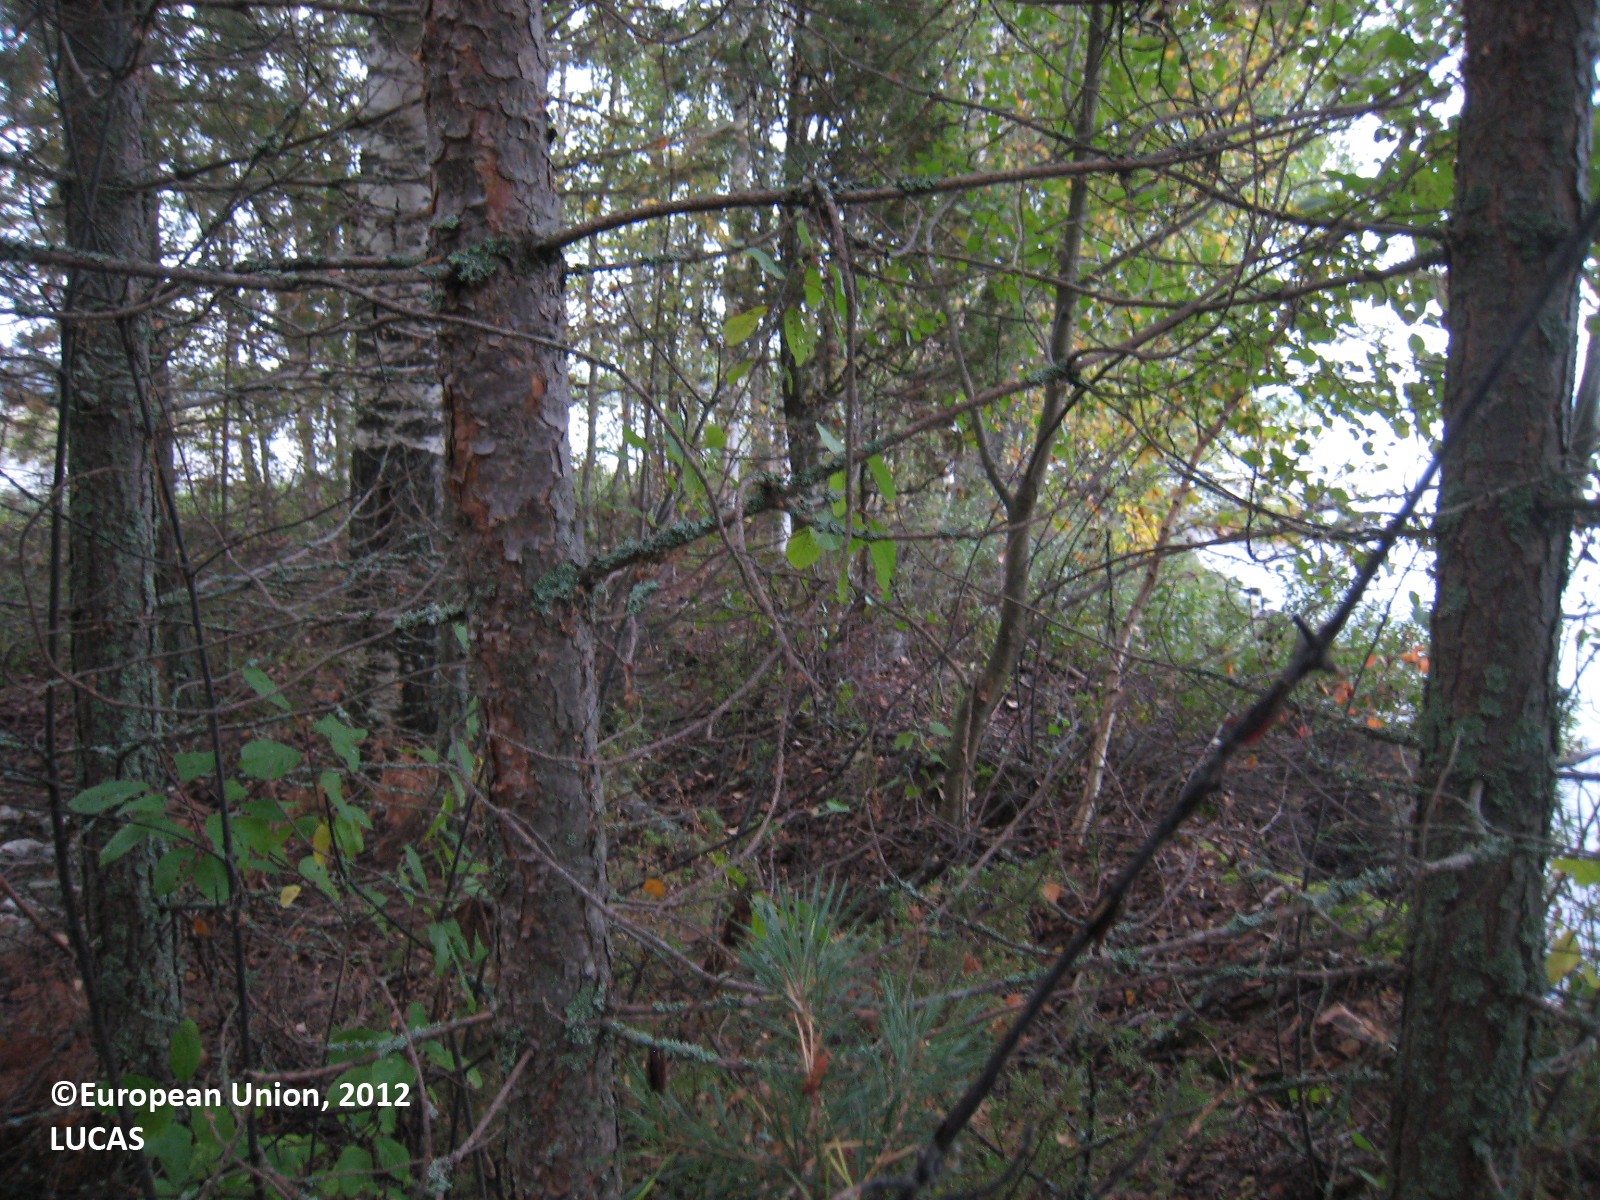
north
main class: Woodland
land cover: Pine dominated mixed woodland
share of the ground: > 75 %
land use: Semi-natural and natural areas not in use
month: September
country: FI
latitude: 61.6330
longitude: 26.0387
